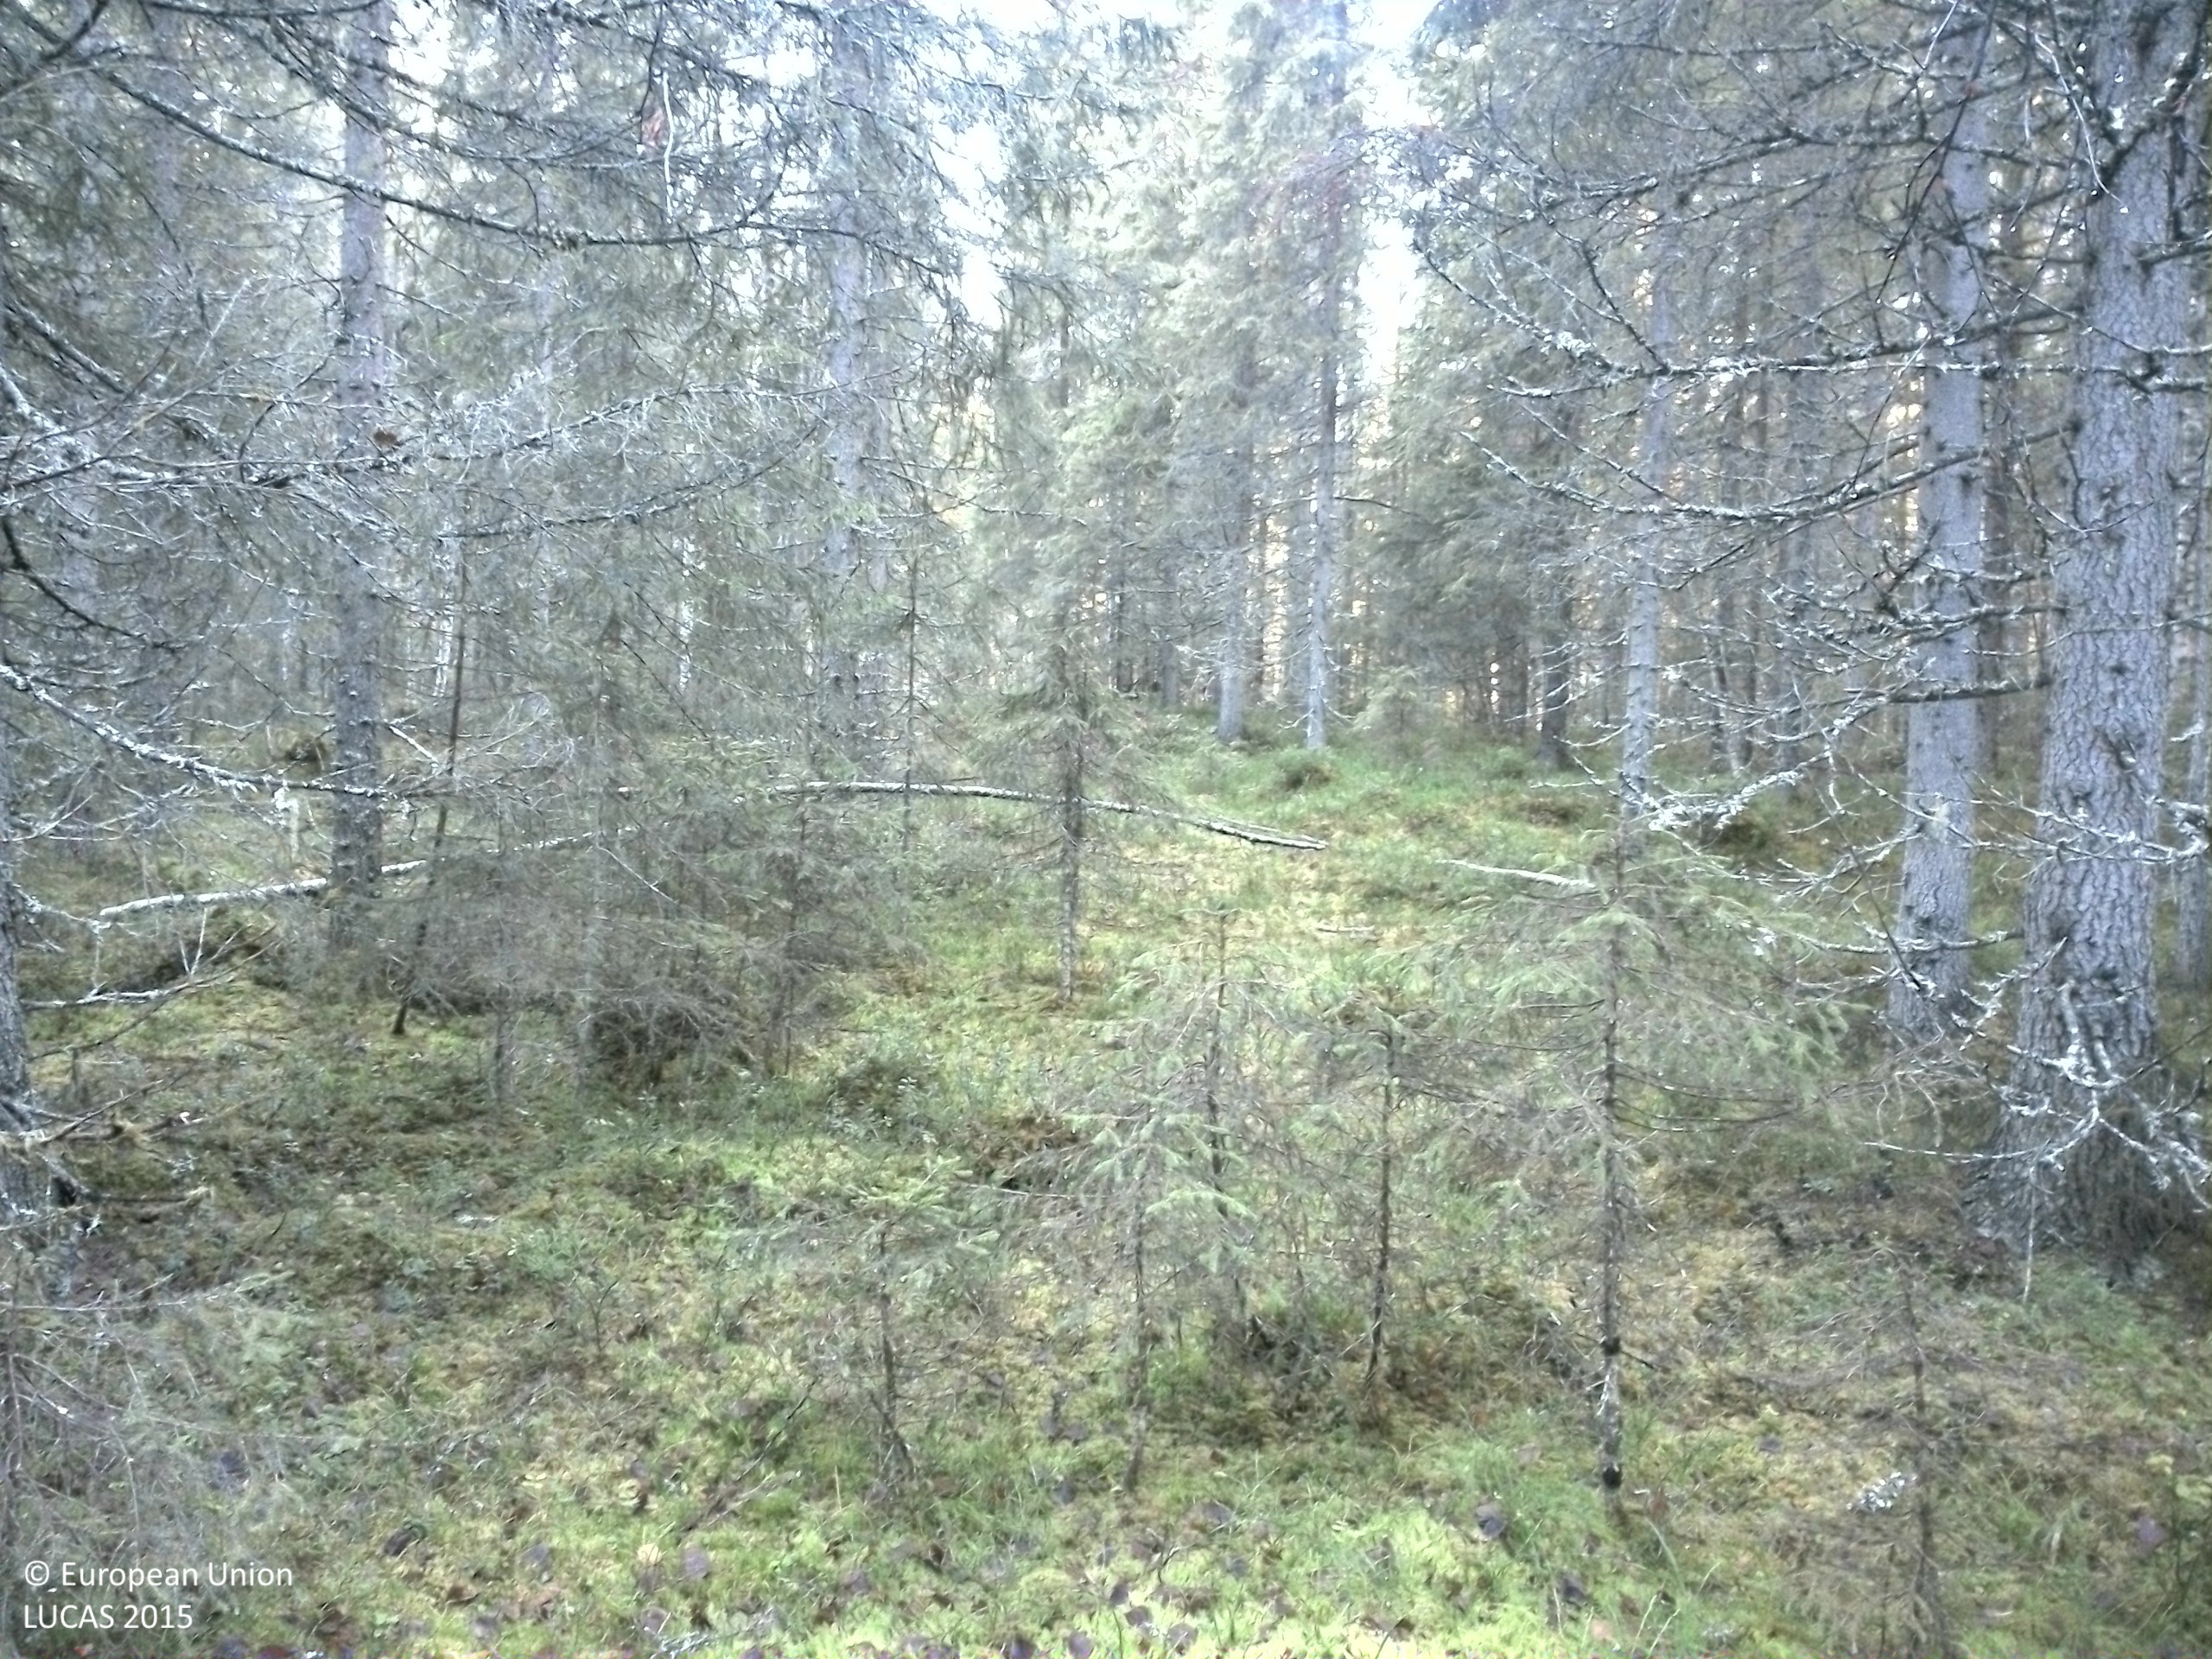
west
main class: Woodland
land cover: Spruce dominated mixed woodland
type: boreal forest
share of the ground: 50 - 75 %
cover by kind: coniferous forest trees 45 %, lichens and mosses 25 %, broadleaved forest trees 15 %, shrubs 15 %
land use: Forestry
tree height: > 5 m
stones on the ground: 25 - 50 %
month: October
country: SE
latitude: 63.8675
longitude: 16.0161
